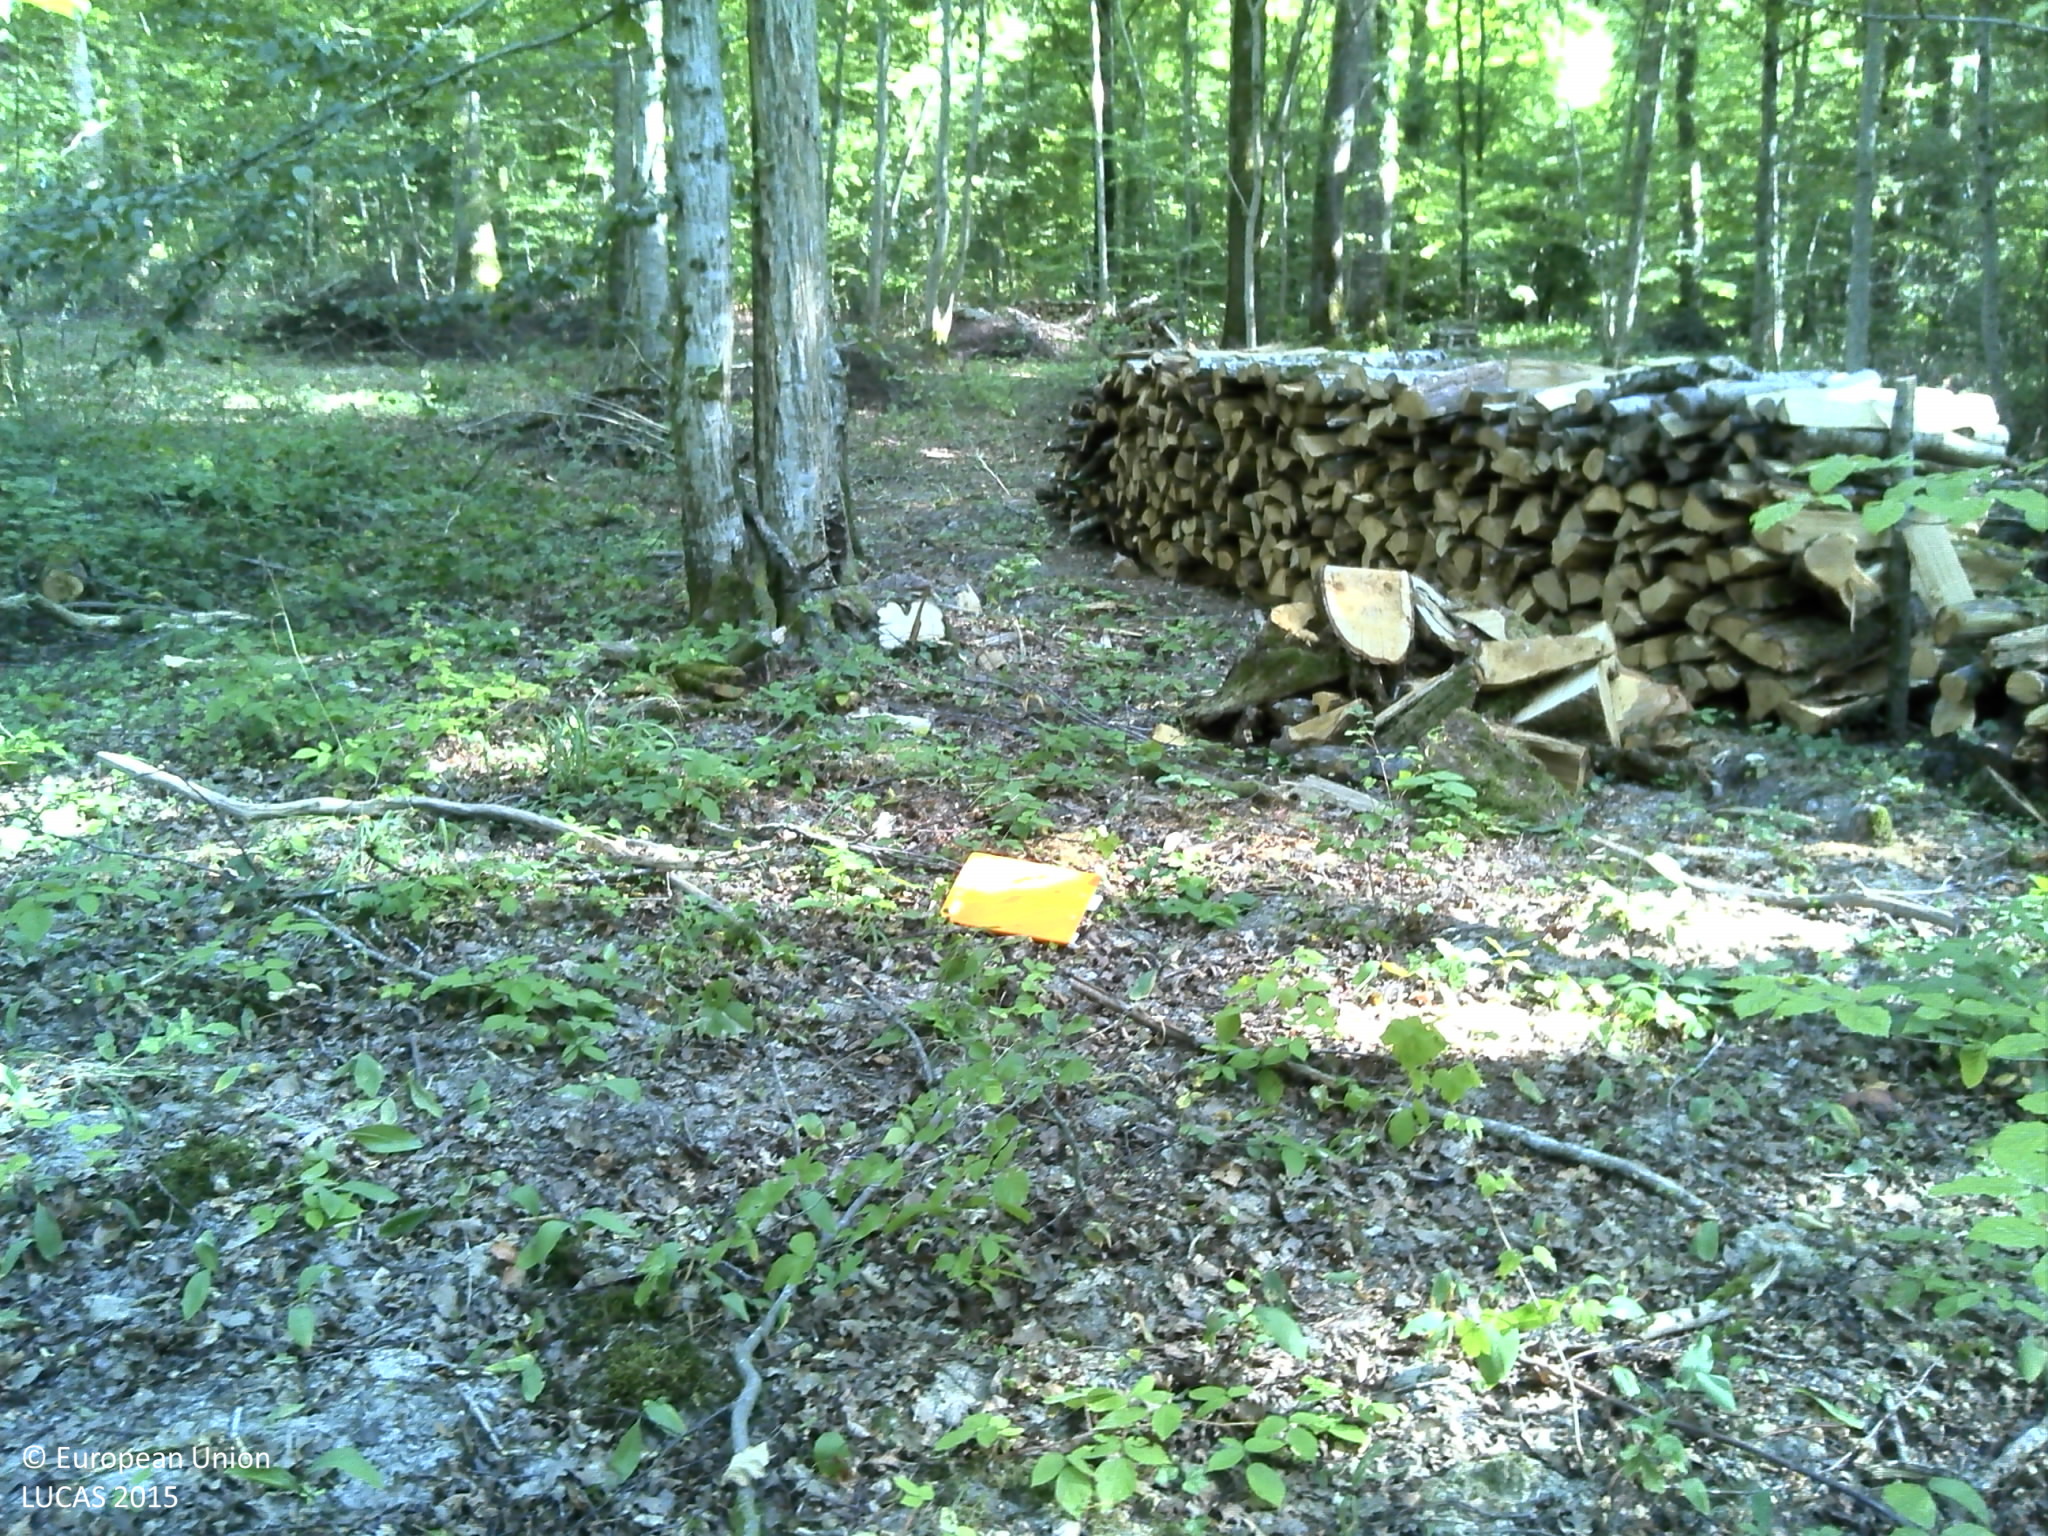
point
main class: Woodland
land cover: Broadleaved woodland
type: beech forest
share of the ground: > 75 %
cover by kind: broadleaved forest trees 100 %
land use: Forestry
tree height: > 5 m
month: July
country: FR
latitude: 48.2620
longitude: 6.0803
